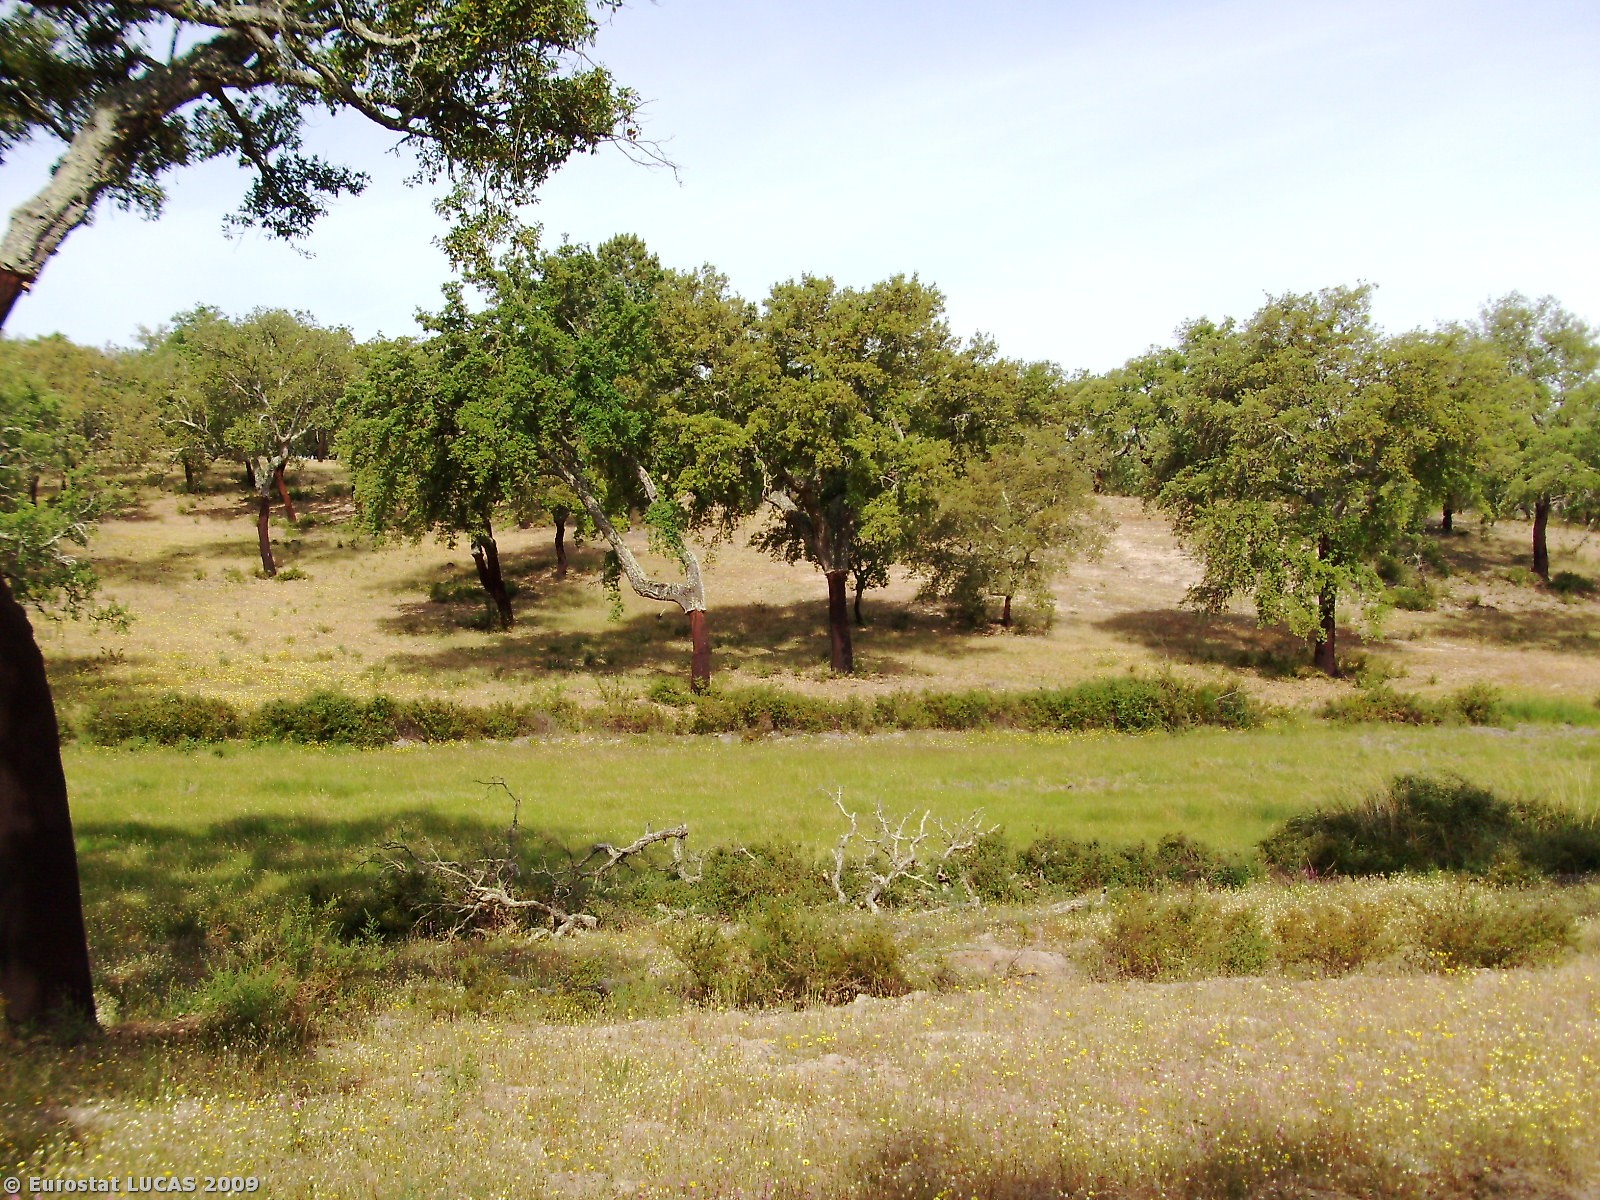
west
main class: Woodland
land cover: Broadleaved woodland
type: broadleaved evergreen forest
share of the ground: 50 - 75 %
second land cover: Spontaneously vegetated surfaces
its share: 25 - 50 %
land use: Forestry
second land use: Fallow land
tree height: > 5 m
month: May
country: PT
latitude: 39.0633
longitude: -8.0228
